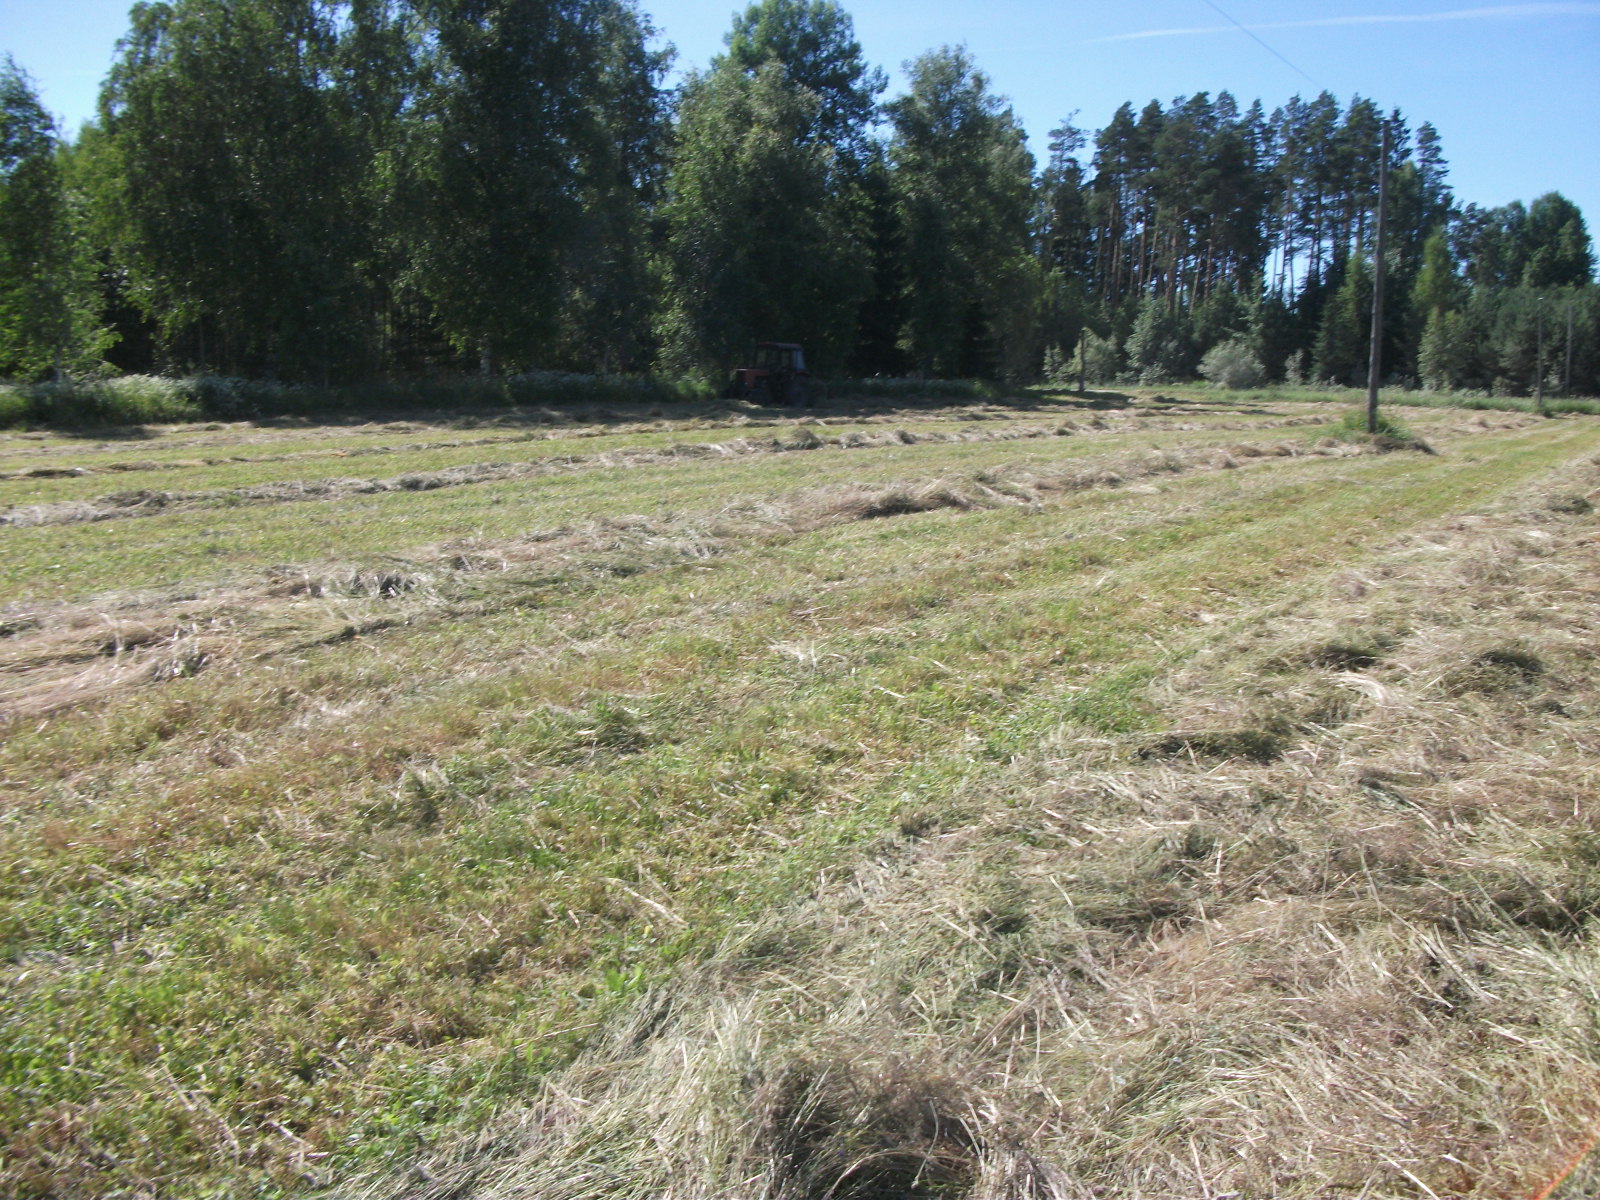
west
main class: Grassland
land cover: Grassland without tree/shrub cover
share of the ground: > 75 %
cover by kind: herbaceous plants 100 %
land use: Agriculture (excluding fallow land and kitchen gardens)
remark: Harvested field
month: July
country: LV
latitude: 56.7477
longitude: 26.3471
